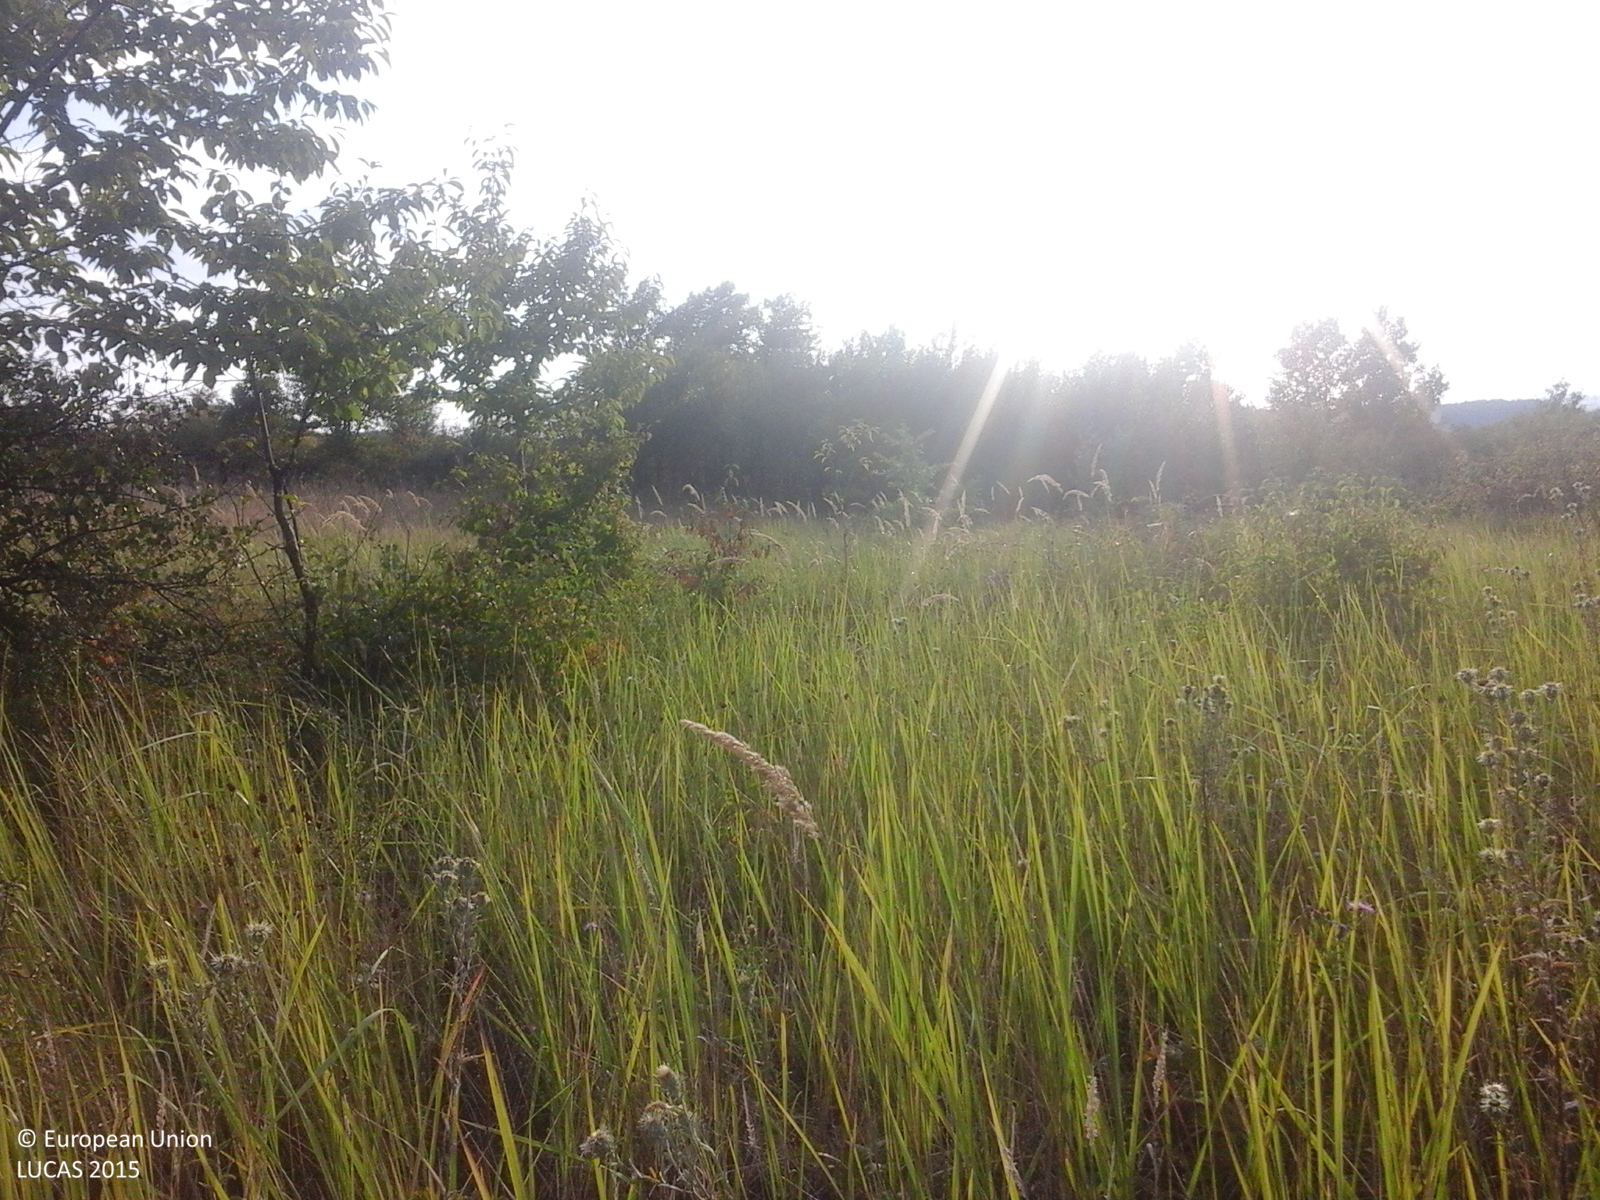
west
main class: Grassland
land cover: Grassland with sparse tree/shrub cover
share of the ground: > 75 %
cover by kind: herbaceous plants 85 %, shrubs 10 %, broadleaved forest trees 5 %
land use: Semi-natural and natural areas not in use
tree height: < 5 m
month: August
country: RO
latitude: 46.5312
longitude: 21.9736
